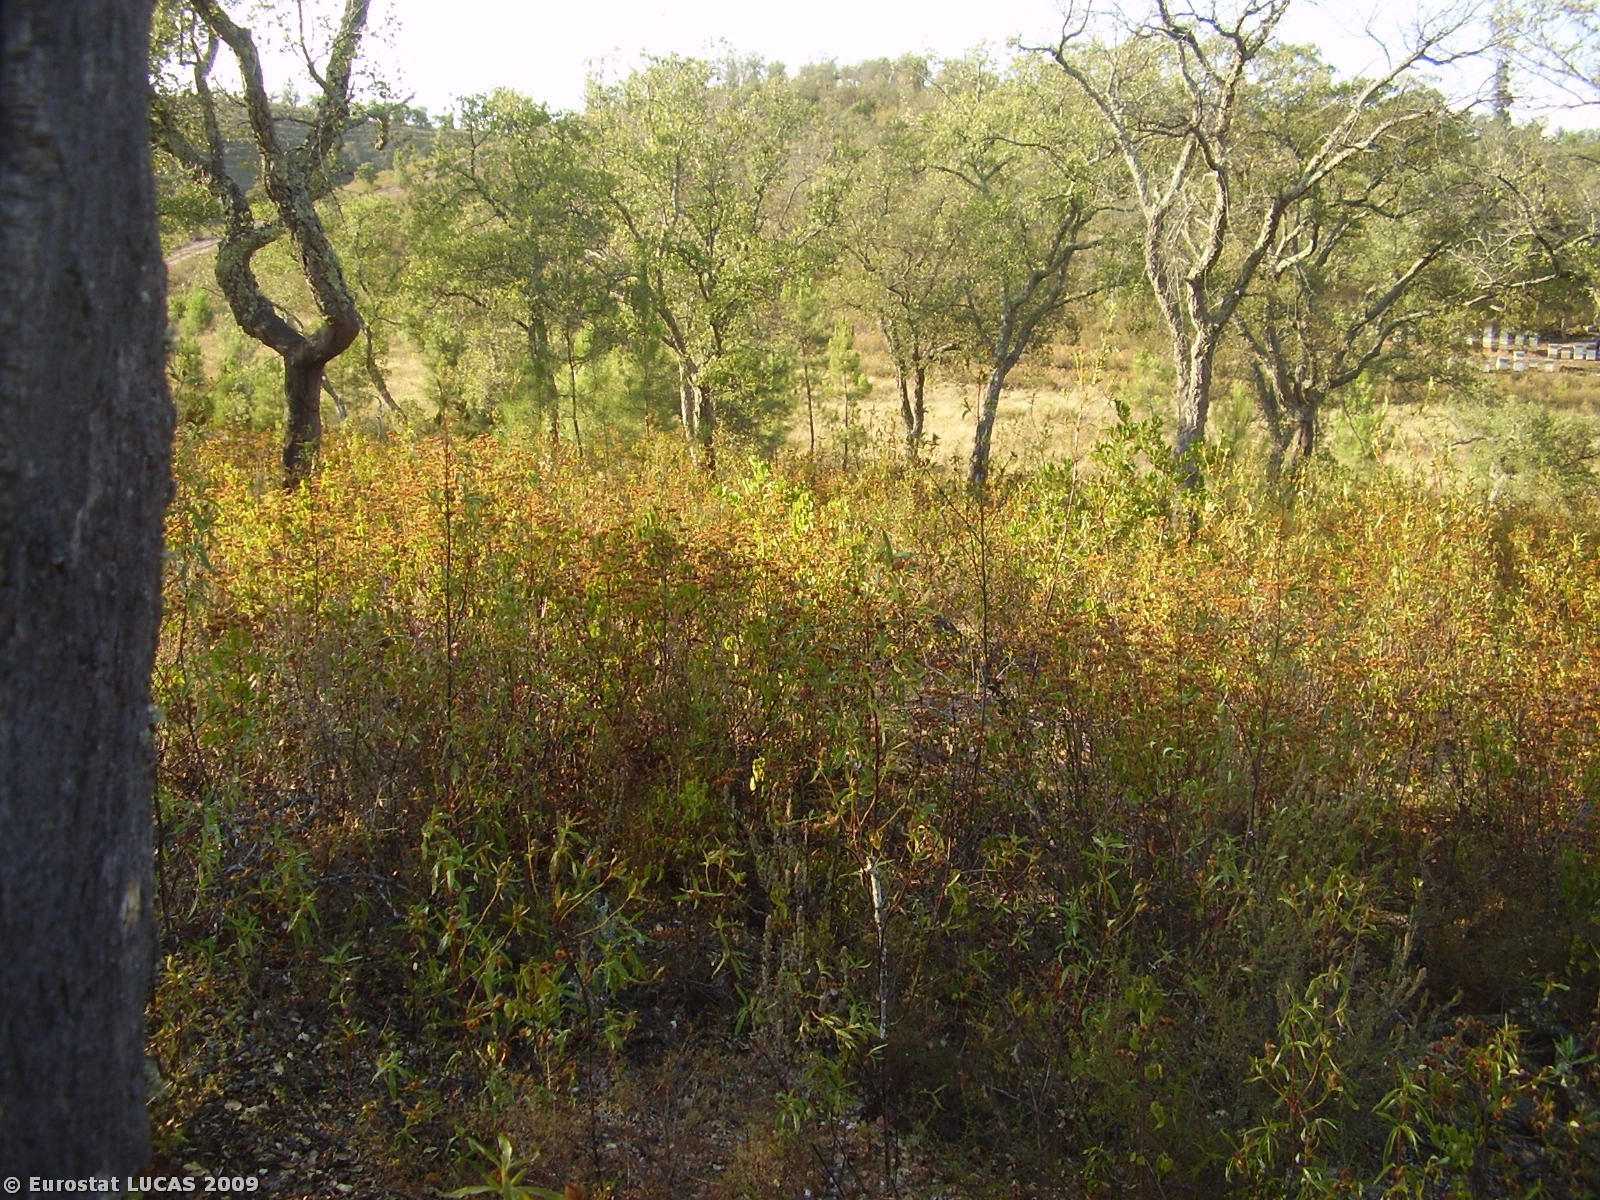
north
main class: Woodland
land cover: Broadleaved woodland
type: broadleaved evergreen forest
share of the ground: 10 - 25 %
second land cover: Shrubland with sparse tree cover
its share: > 75 %
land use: Forestry
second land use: Fallow land
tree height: > 5 m
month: August
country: PT
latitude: 38.2415
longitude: -7.7739
